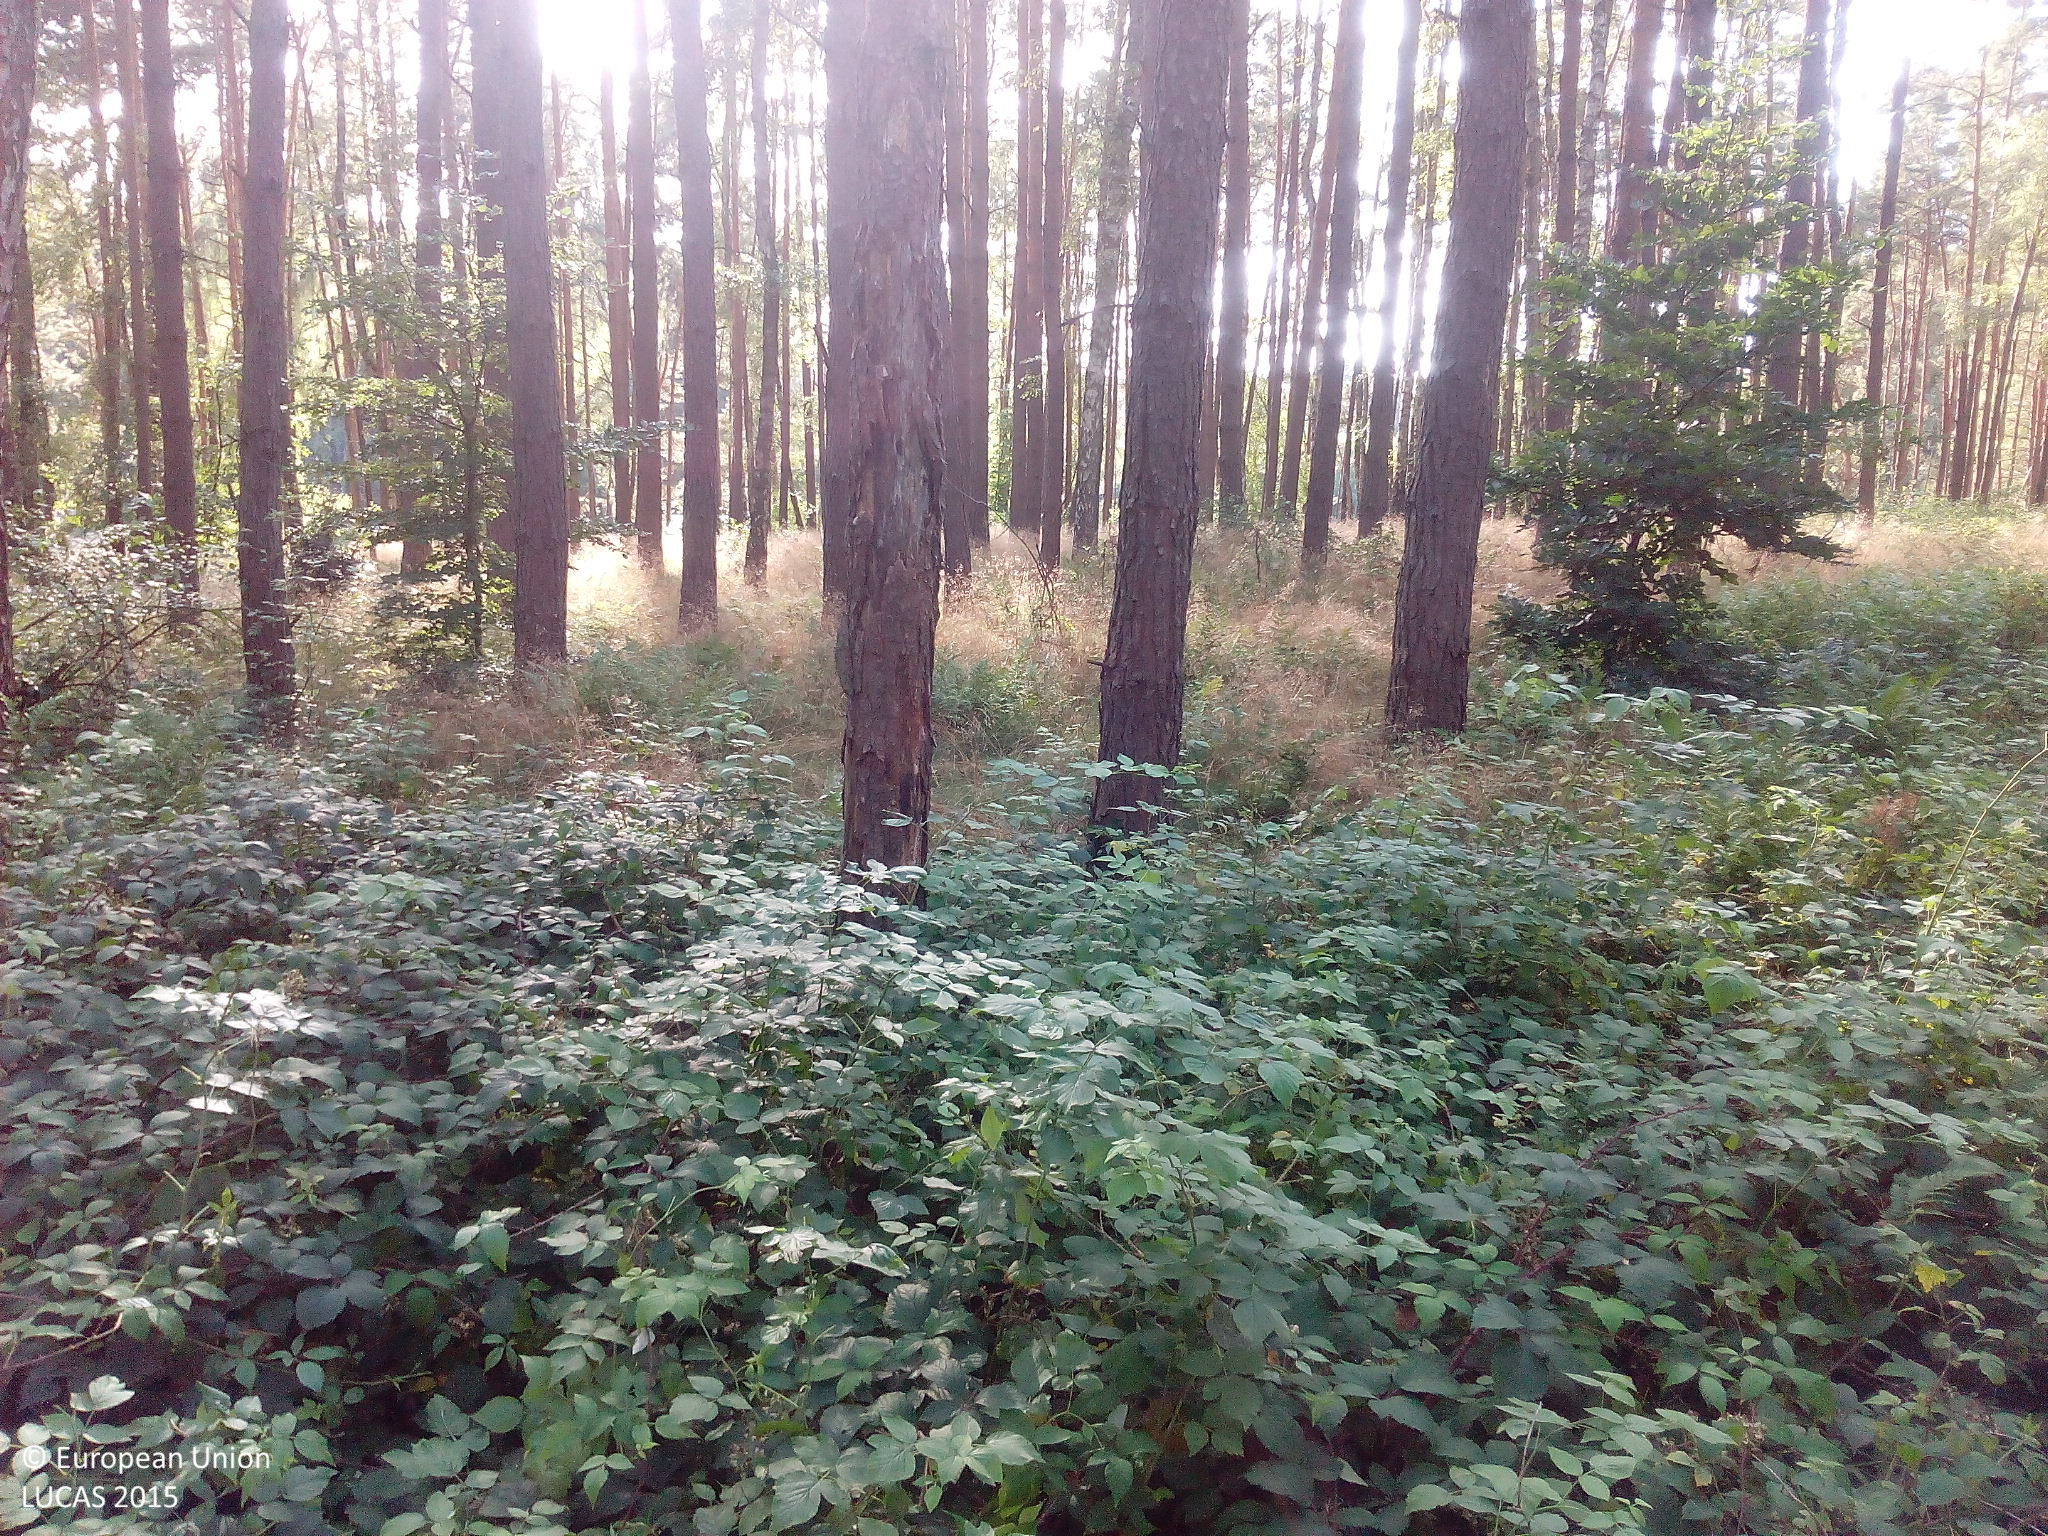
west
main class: Woodland
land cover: Pine dominated coniferous woodland
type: hemiboreal forest and nemoral coniferous forest and mixed broadleaved-coniferous forest
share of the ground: > 75 %
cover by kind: coniferous forest trees 80 %, shrubs 10 %, herbaceous plants 10 %
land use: Forestry
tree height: > 5 m
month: August
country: DE
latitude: 53.5388
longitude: 12.4588
